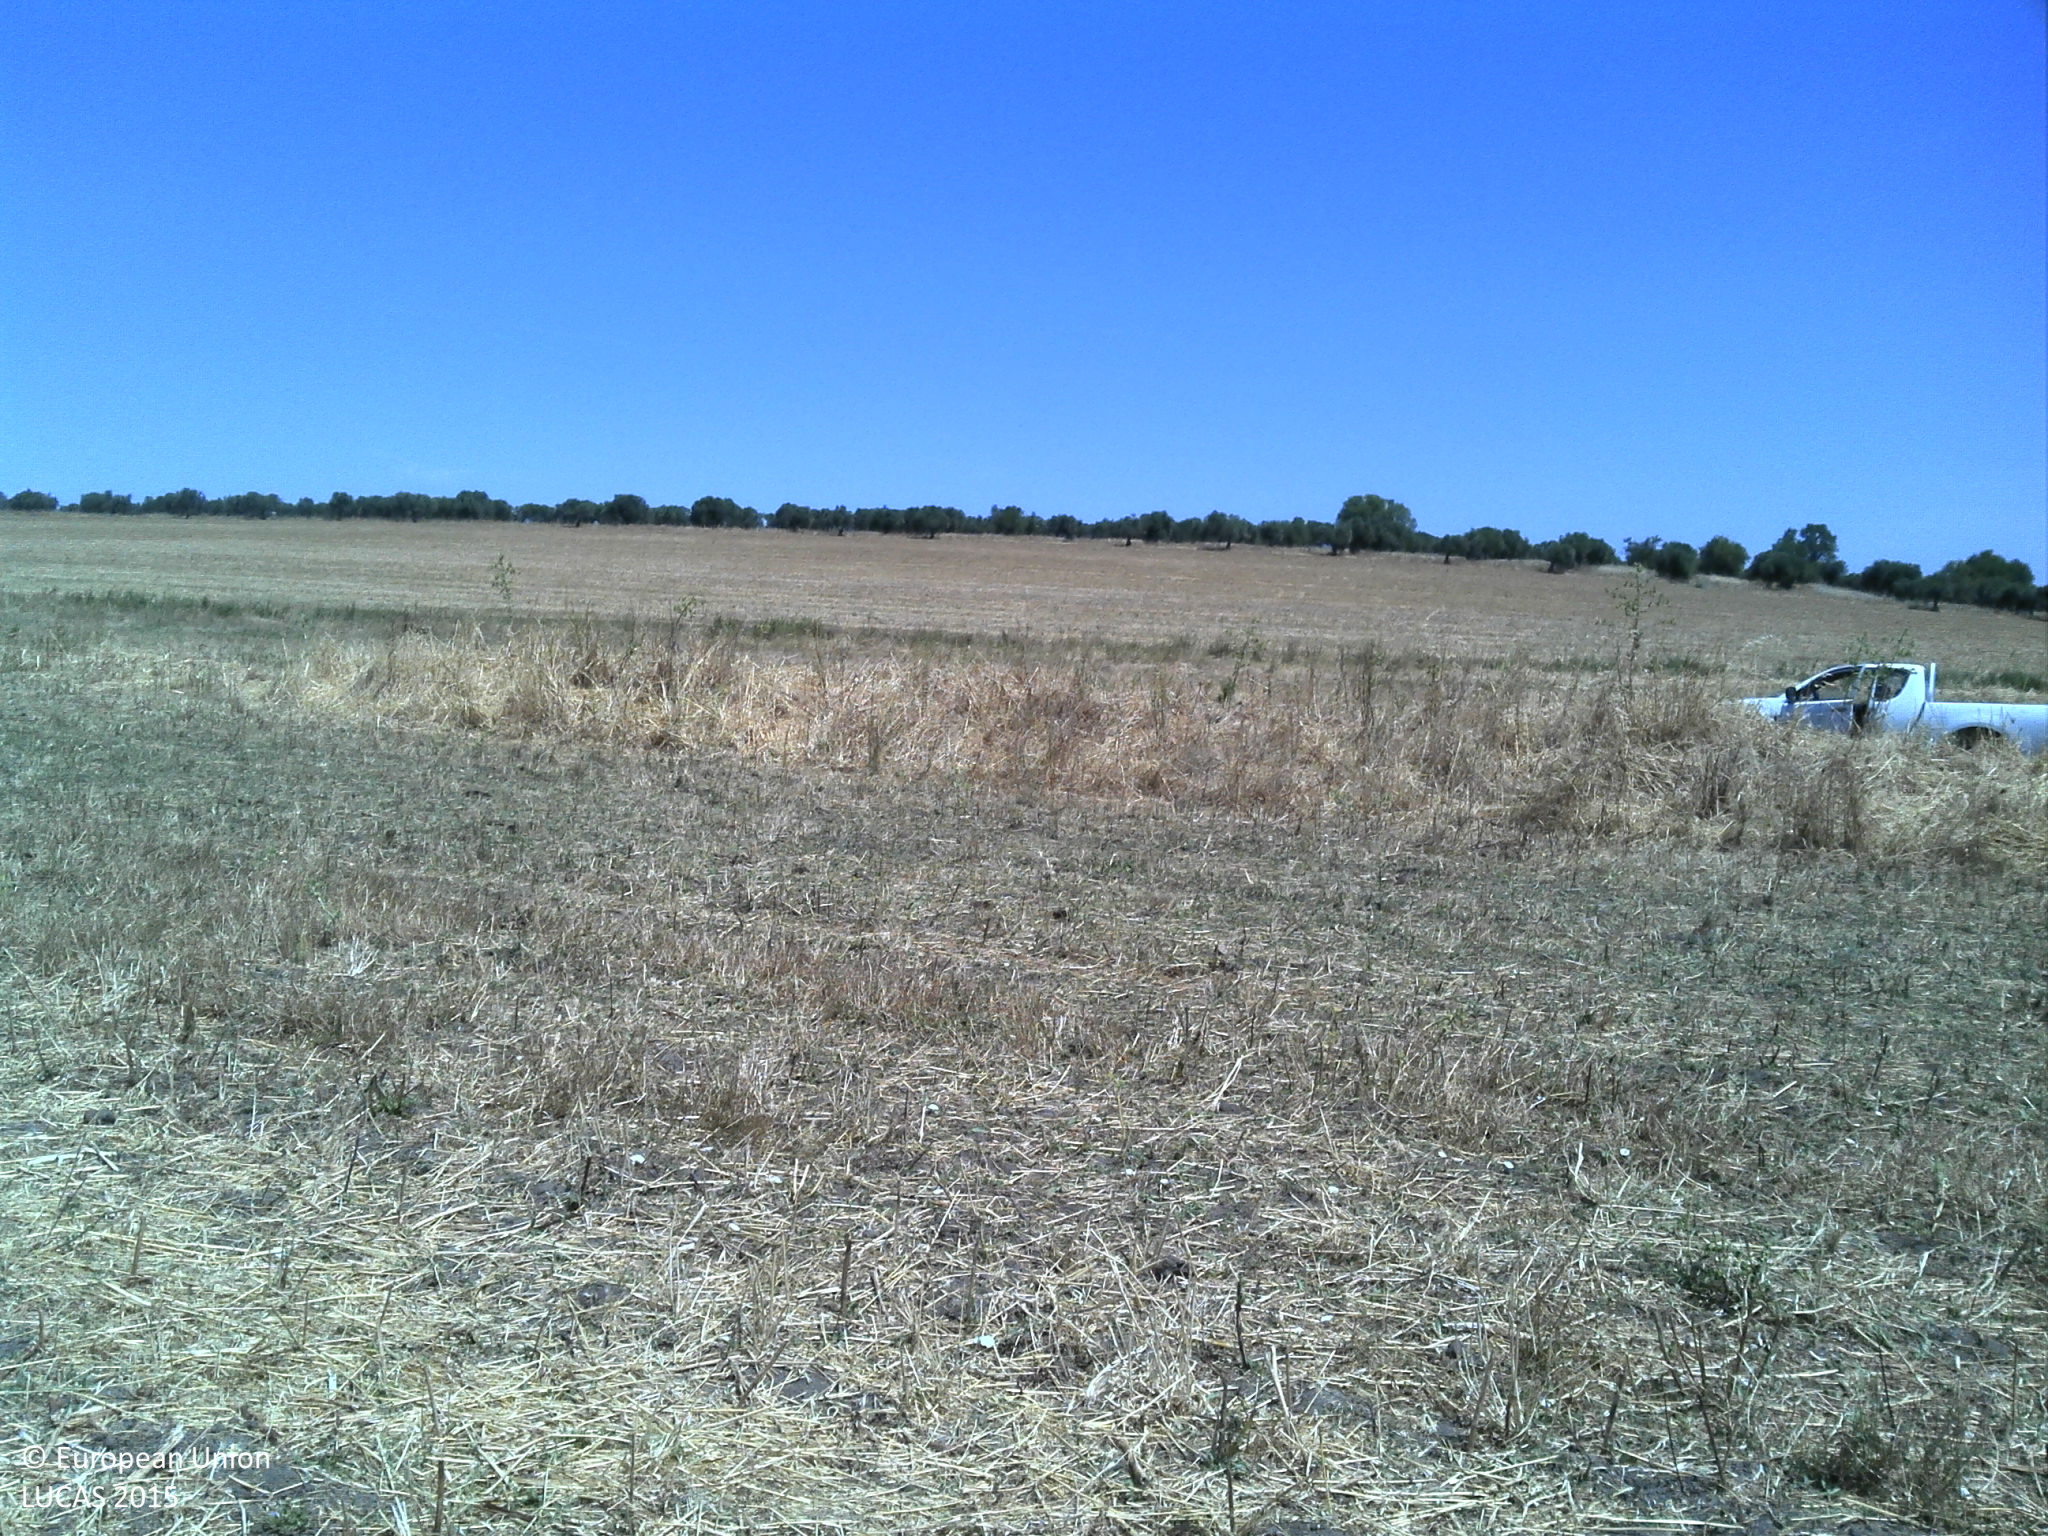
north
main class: Cropland
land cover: Common wheat
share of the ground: > 75 %
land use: Agriculture (excluding fallow land and kitchen gardens)
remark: Harvested field
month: June
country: PT
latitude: 37.9403
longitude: -7.5072
